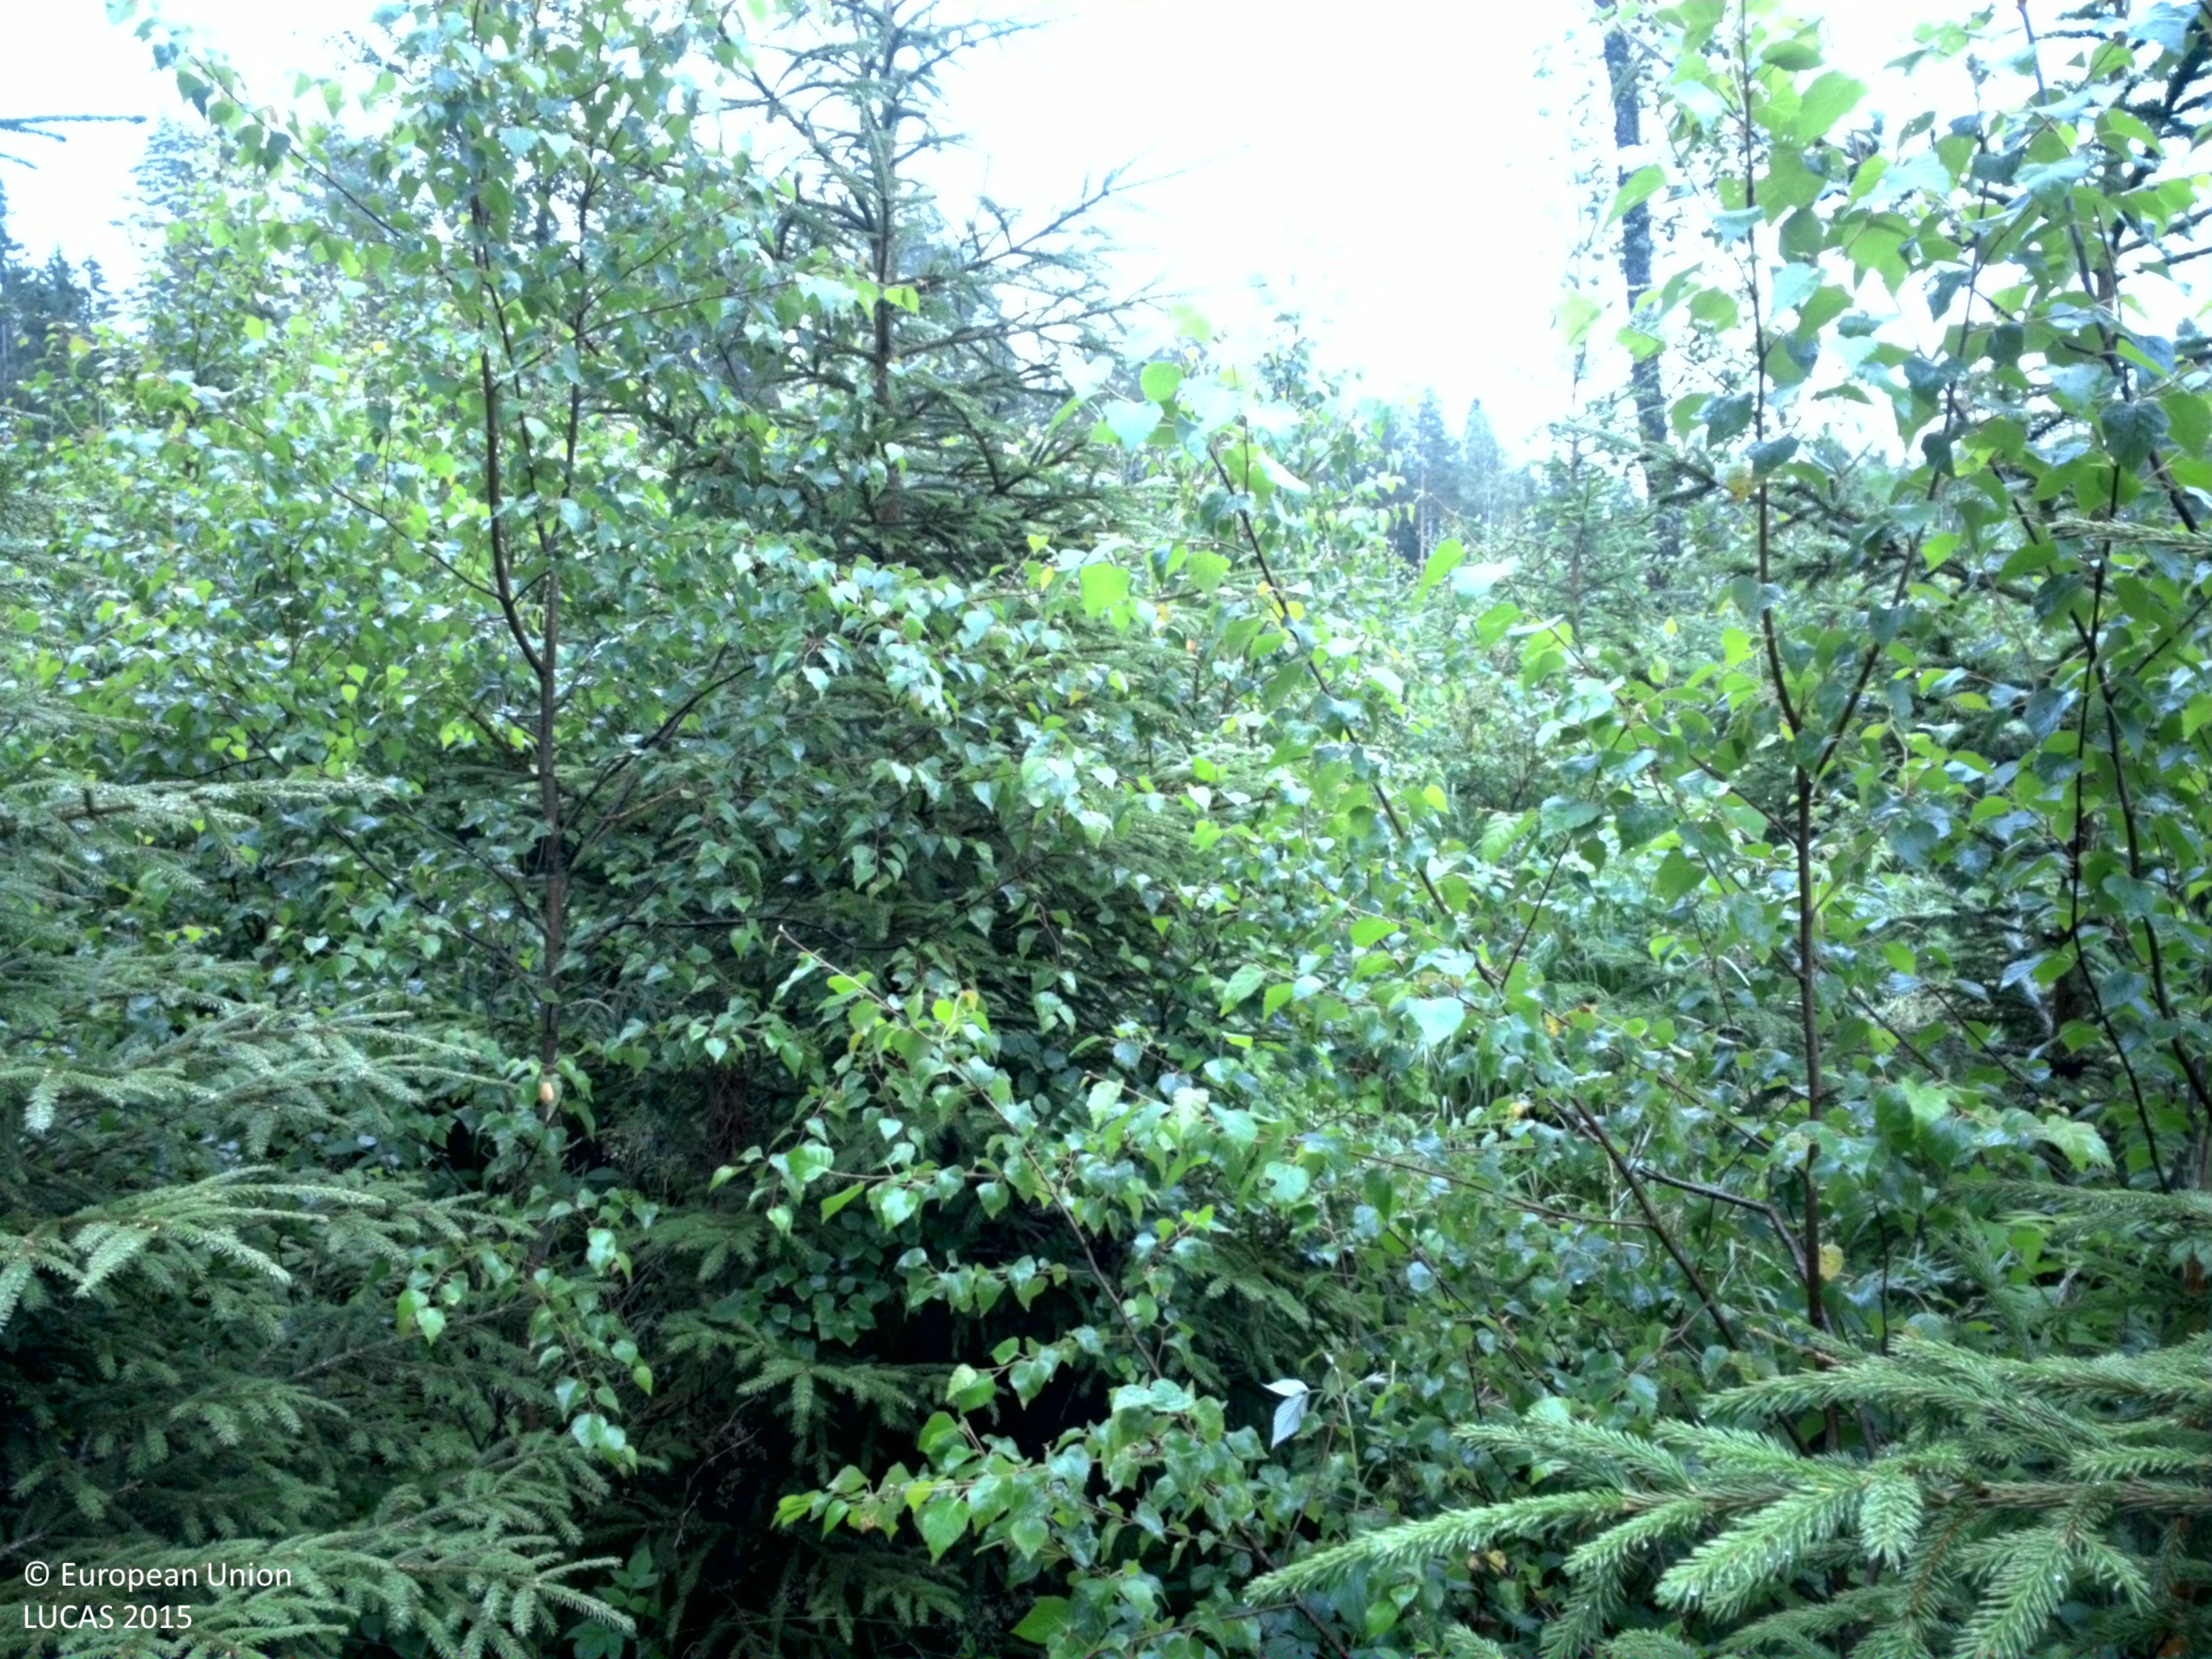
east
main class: Woodland
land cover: Spruce dominated mixed woodland
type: boreal forest
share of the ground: 25 - 50 %
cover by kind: herbaceous plants 60 %, coniferous forest trees 30 %, broadleaved forest trees 10 %
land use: Forestry
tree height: < 5 m
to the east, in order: Spruce dominated mixed woodland; Ditches and canals; Spruce dominated mixed woodland; Pine dominated coniferous woodland; Spruce dominated coniferous woodland; Ditches and canals; Paved roads, cycling and walking lanes; Ditches and canals; Pine dominated coniferous woodland
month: July
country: SE
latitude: 59.9761
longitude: 17.2490
